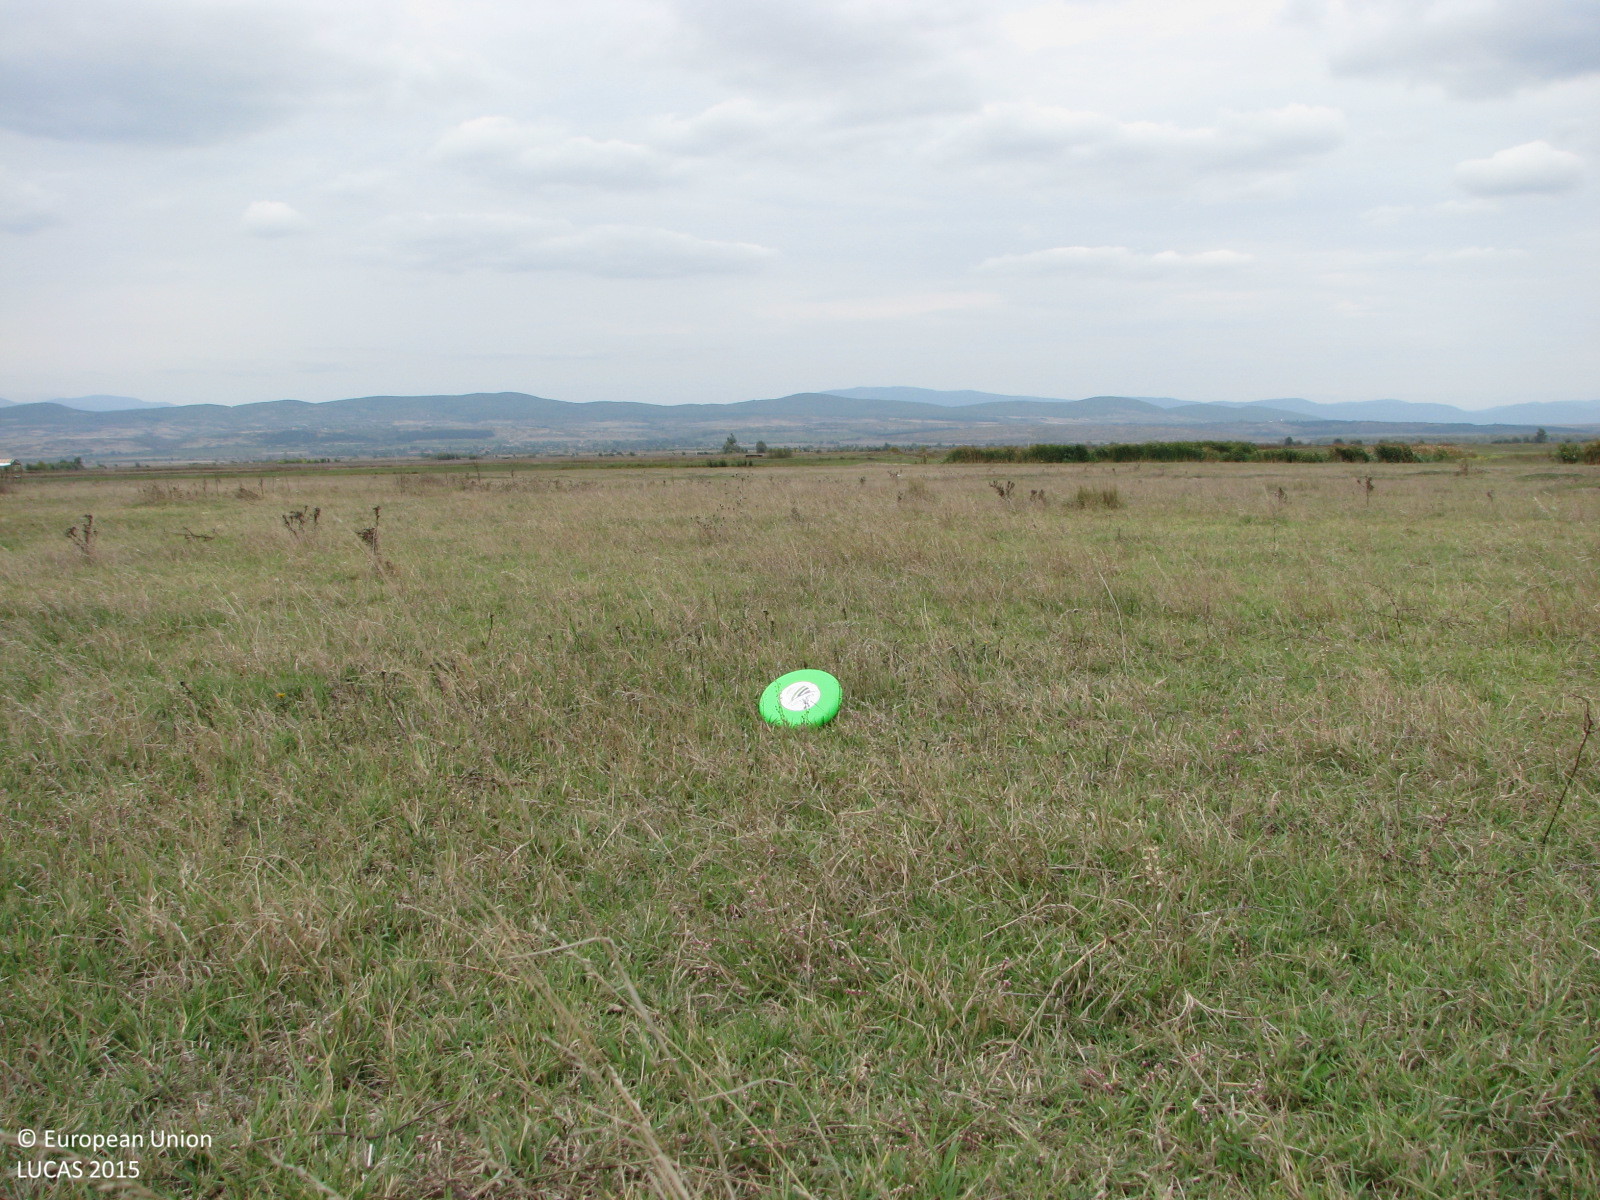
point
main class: Grassland
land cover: Grassland without tree/shrub cover
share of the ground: > 75 %
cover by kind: herbaceous plants 100 %
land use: Agriculture (excluding fallow land and kitchen gardens)
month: October
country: BG
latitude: 42.4943
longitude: 26.1076
